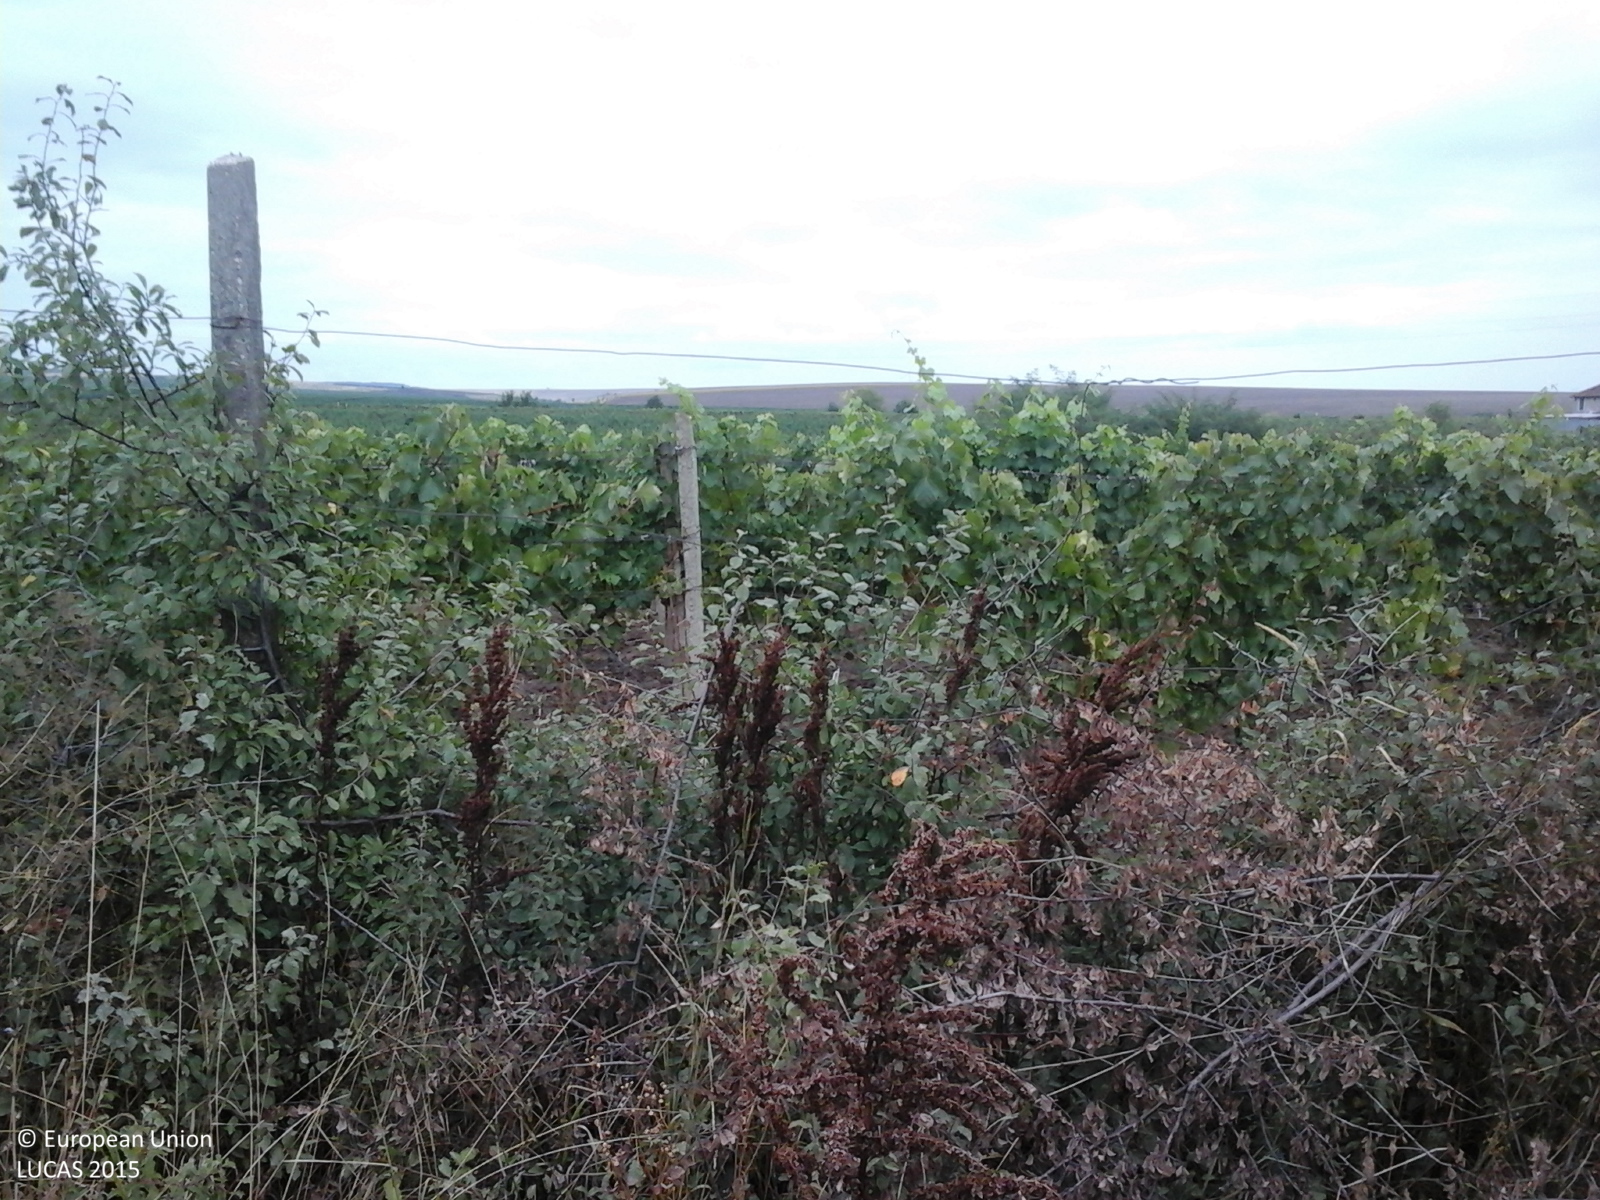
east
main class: Grassland
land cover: Spontaneously vegetated surfaces
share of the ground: > 75 %
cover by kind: herbaceous plants 100 %
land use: Fallow land
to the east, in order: Spontaneously vegetated surfaces; Fences; Vineyards; Tracks; Abandoned hedges; Ditches and canals; Spontaneously vegetated surfaces; Vineyards; Electric lines; Vineyards; Grass margins; Paved roads, cycling and walking lanes; Grass margins; Vineyards
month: August
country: RO
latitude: 45.8167
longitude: 21.5273
